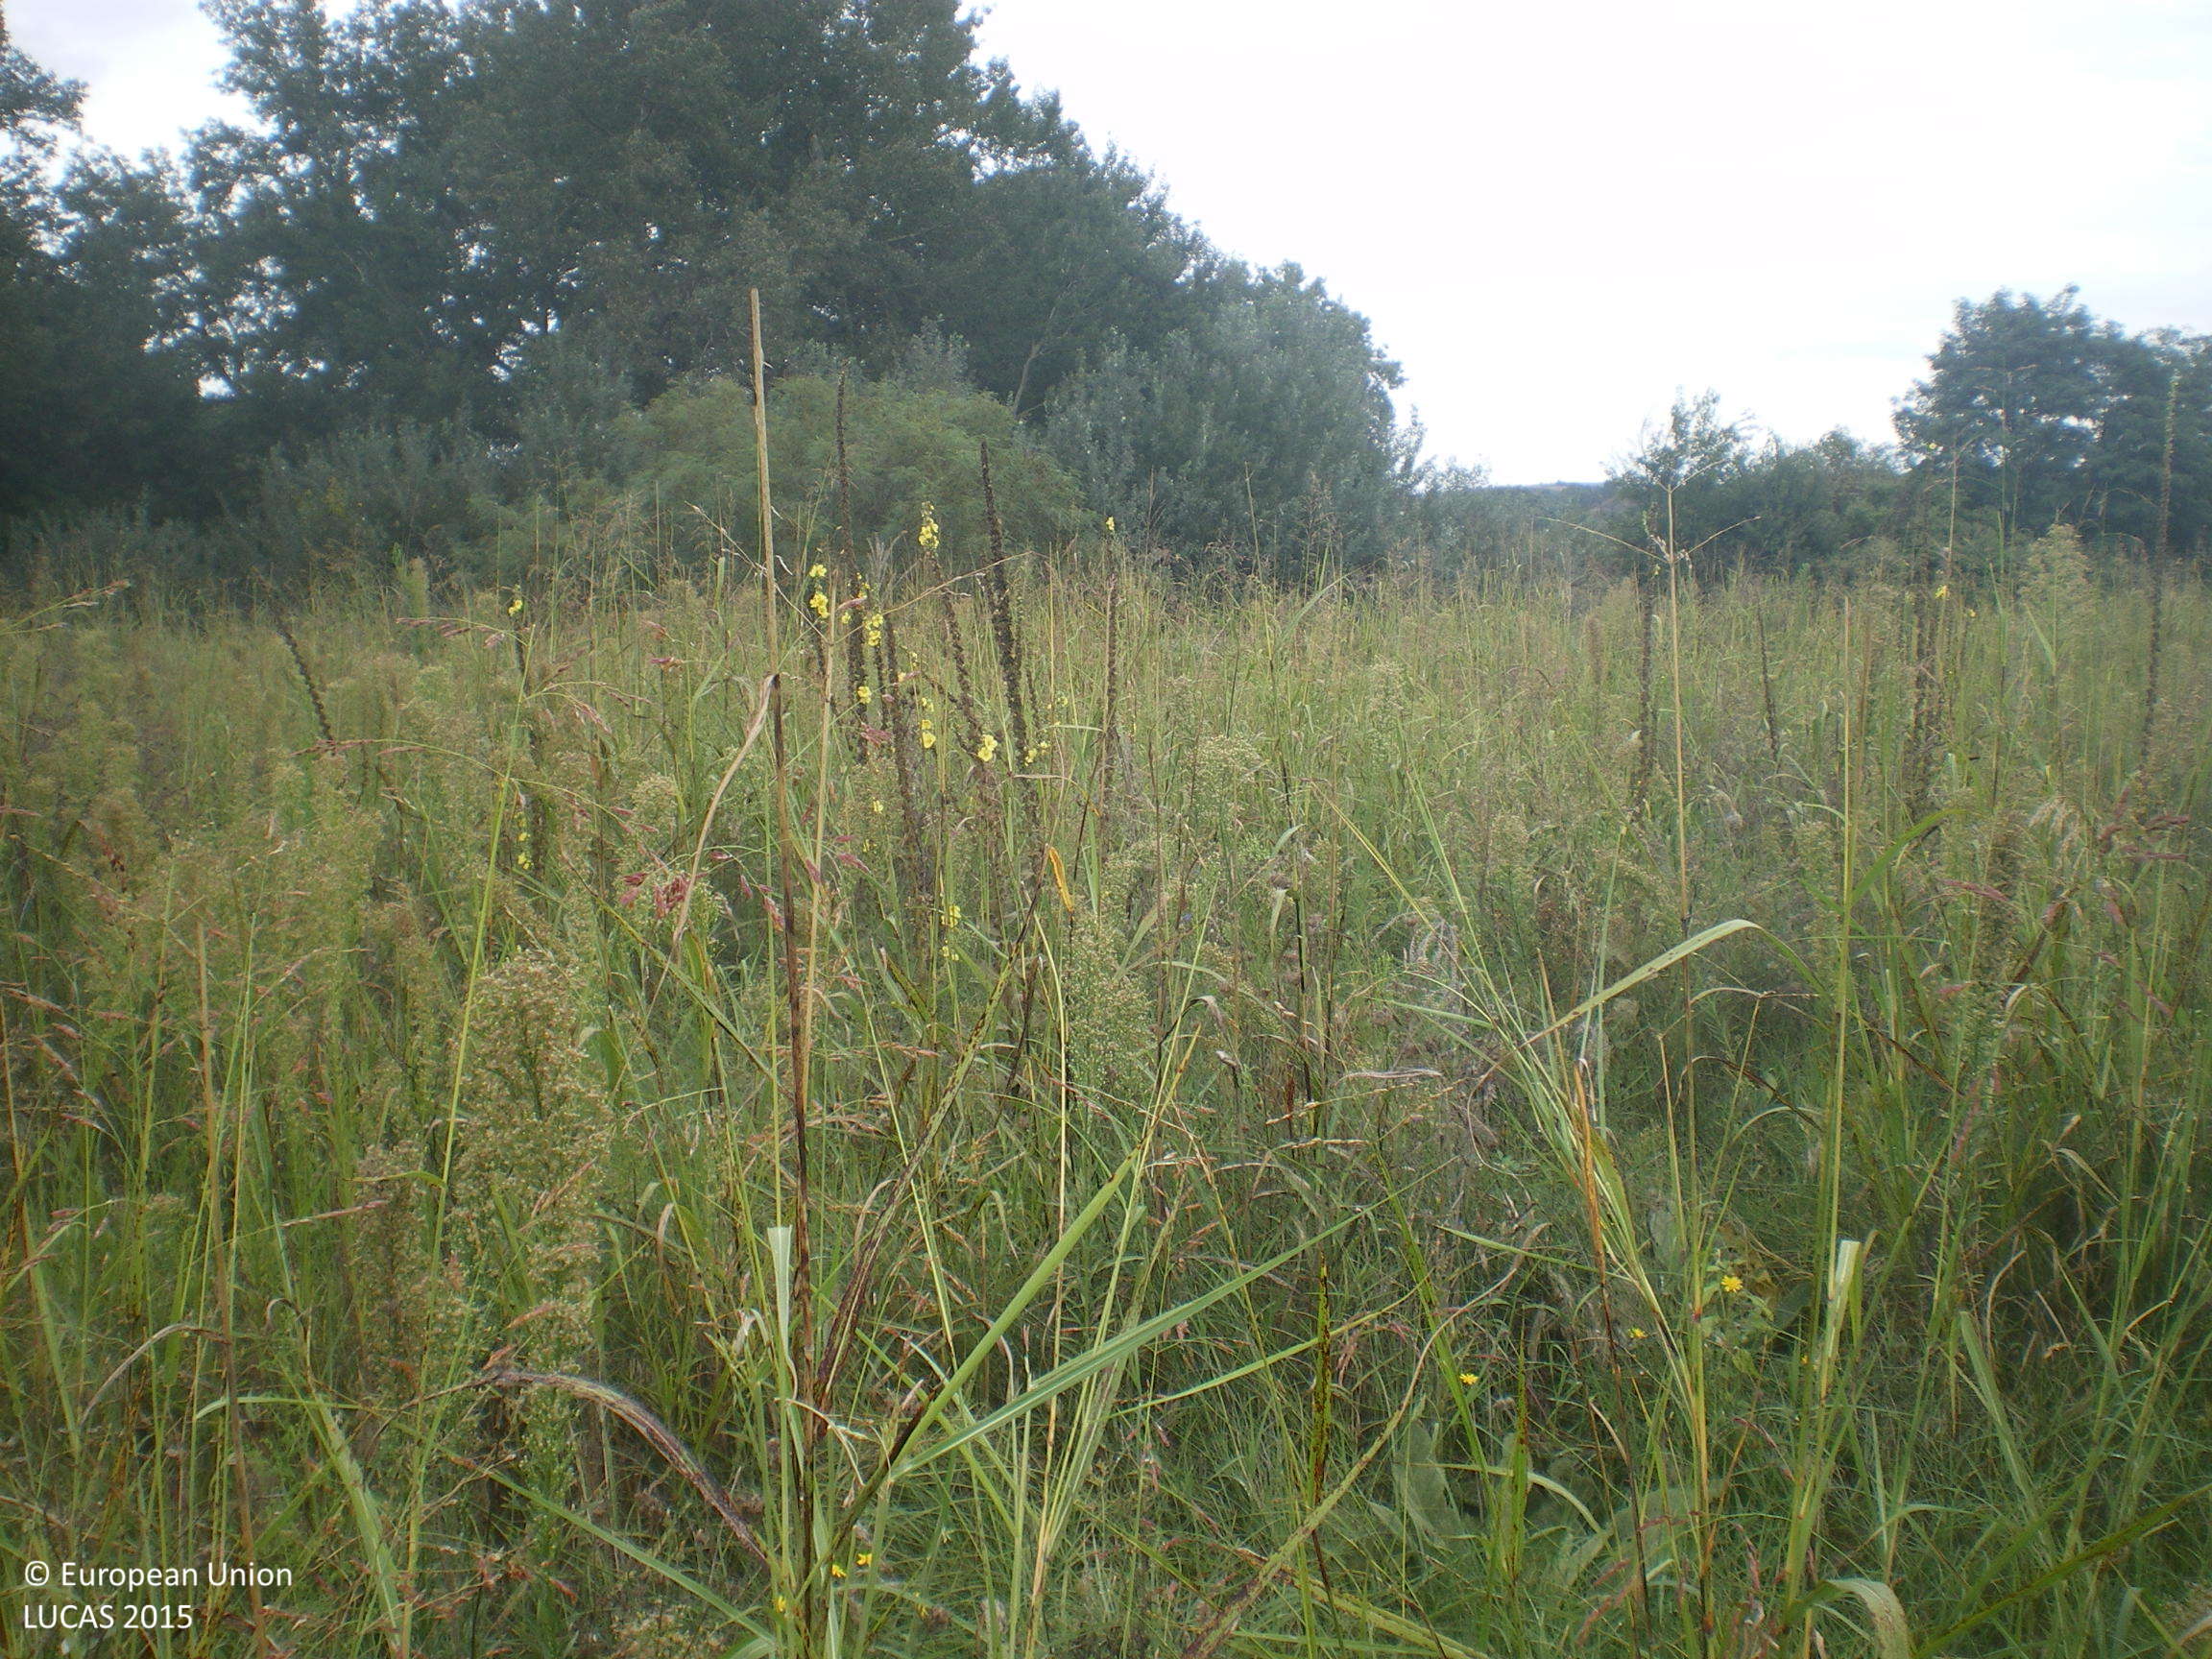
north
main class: Grassland
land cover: Spontaneously vegetated surfaces
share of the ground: > 75 %
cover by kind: herbaceous plants 100 %
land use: Fallow land
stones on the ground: < 10 %
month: September
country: BG
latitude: 41.9348
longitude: 25.9316
